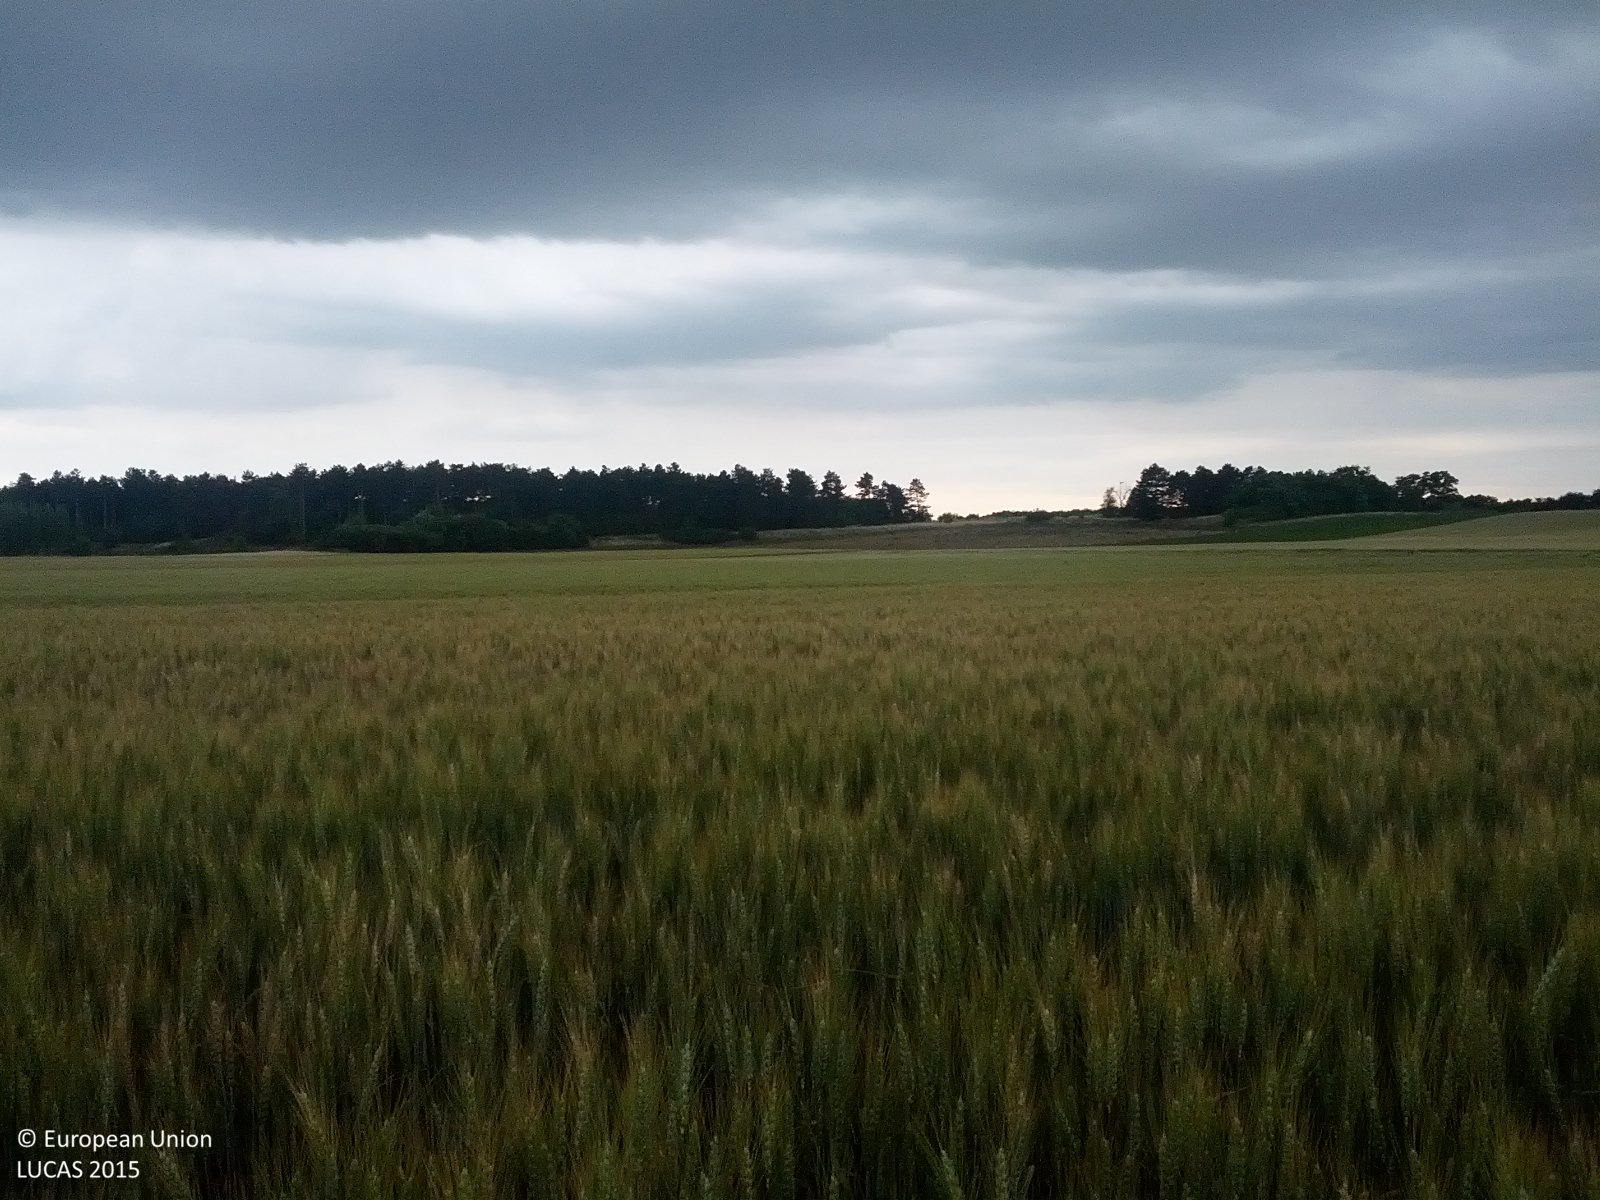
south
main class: Cropland
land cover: Common wheat
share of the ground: > 75 %
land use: Agriculture (excluding fallow land and kitchen gardens)
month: June
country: AT
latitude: 48.2803
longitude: 16.8662
